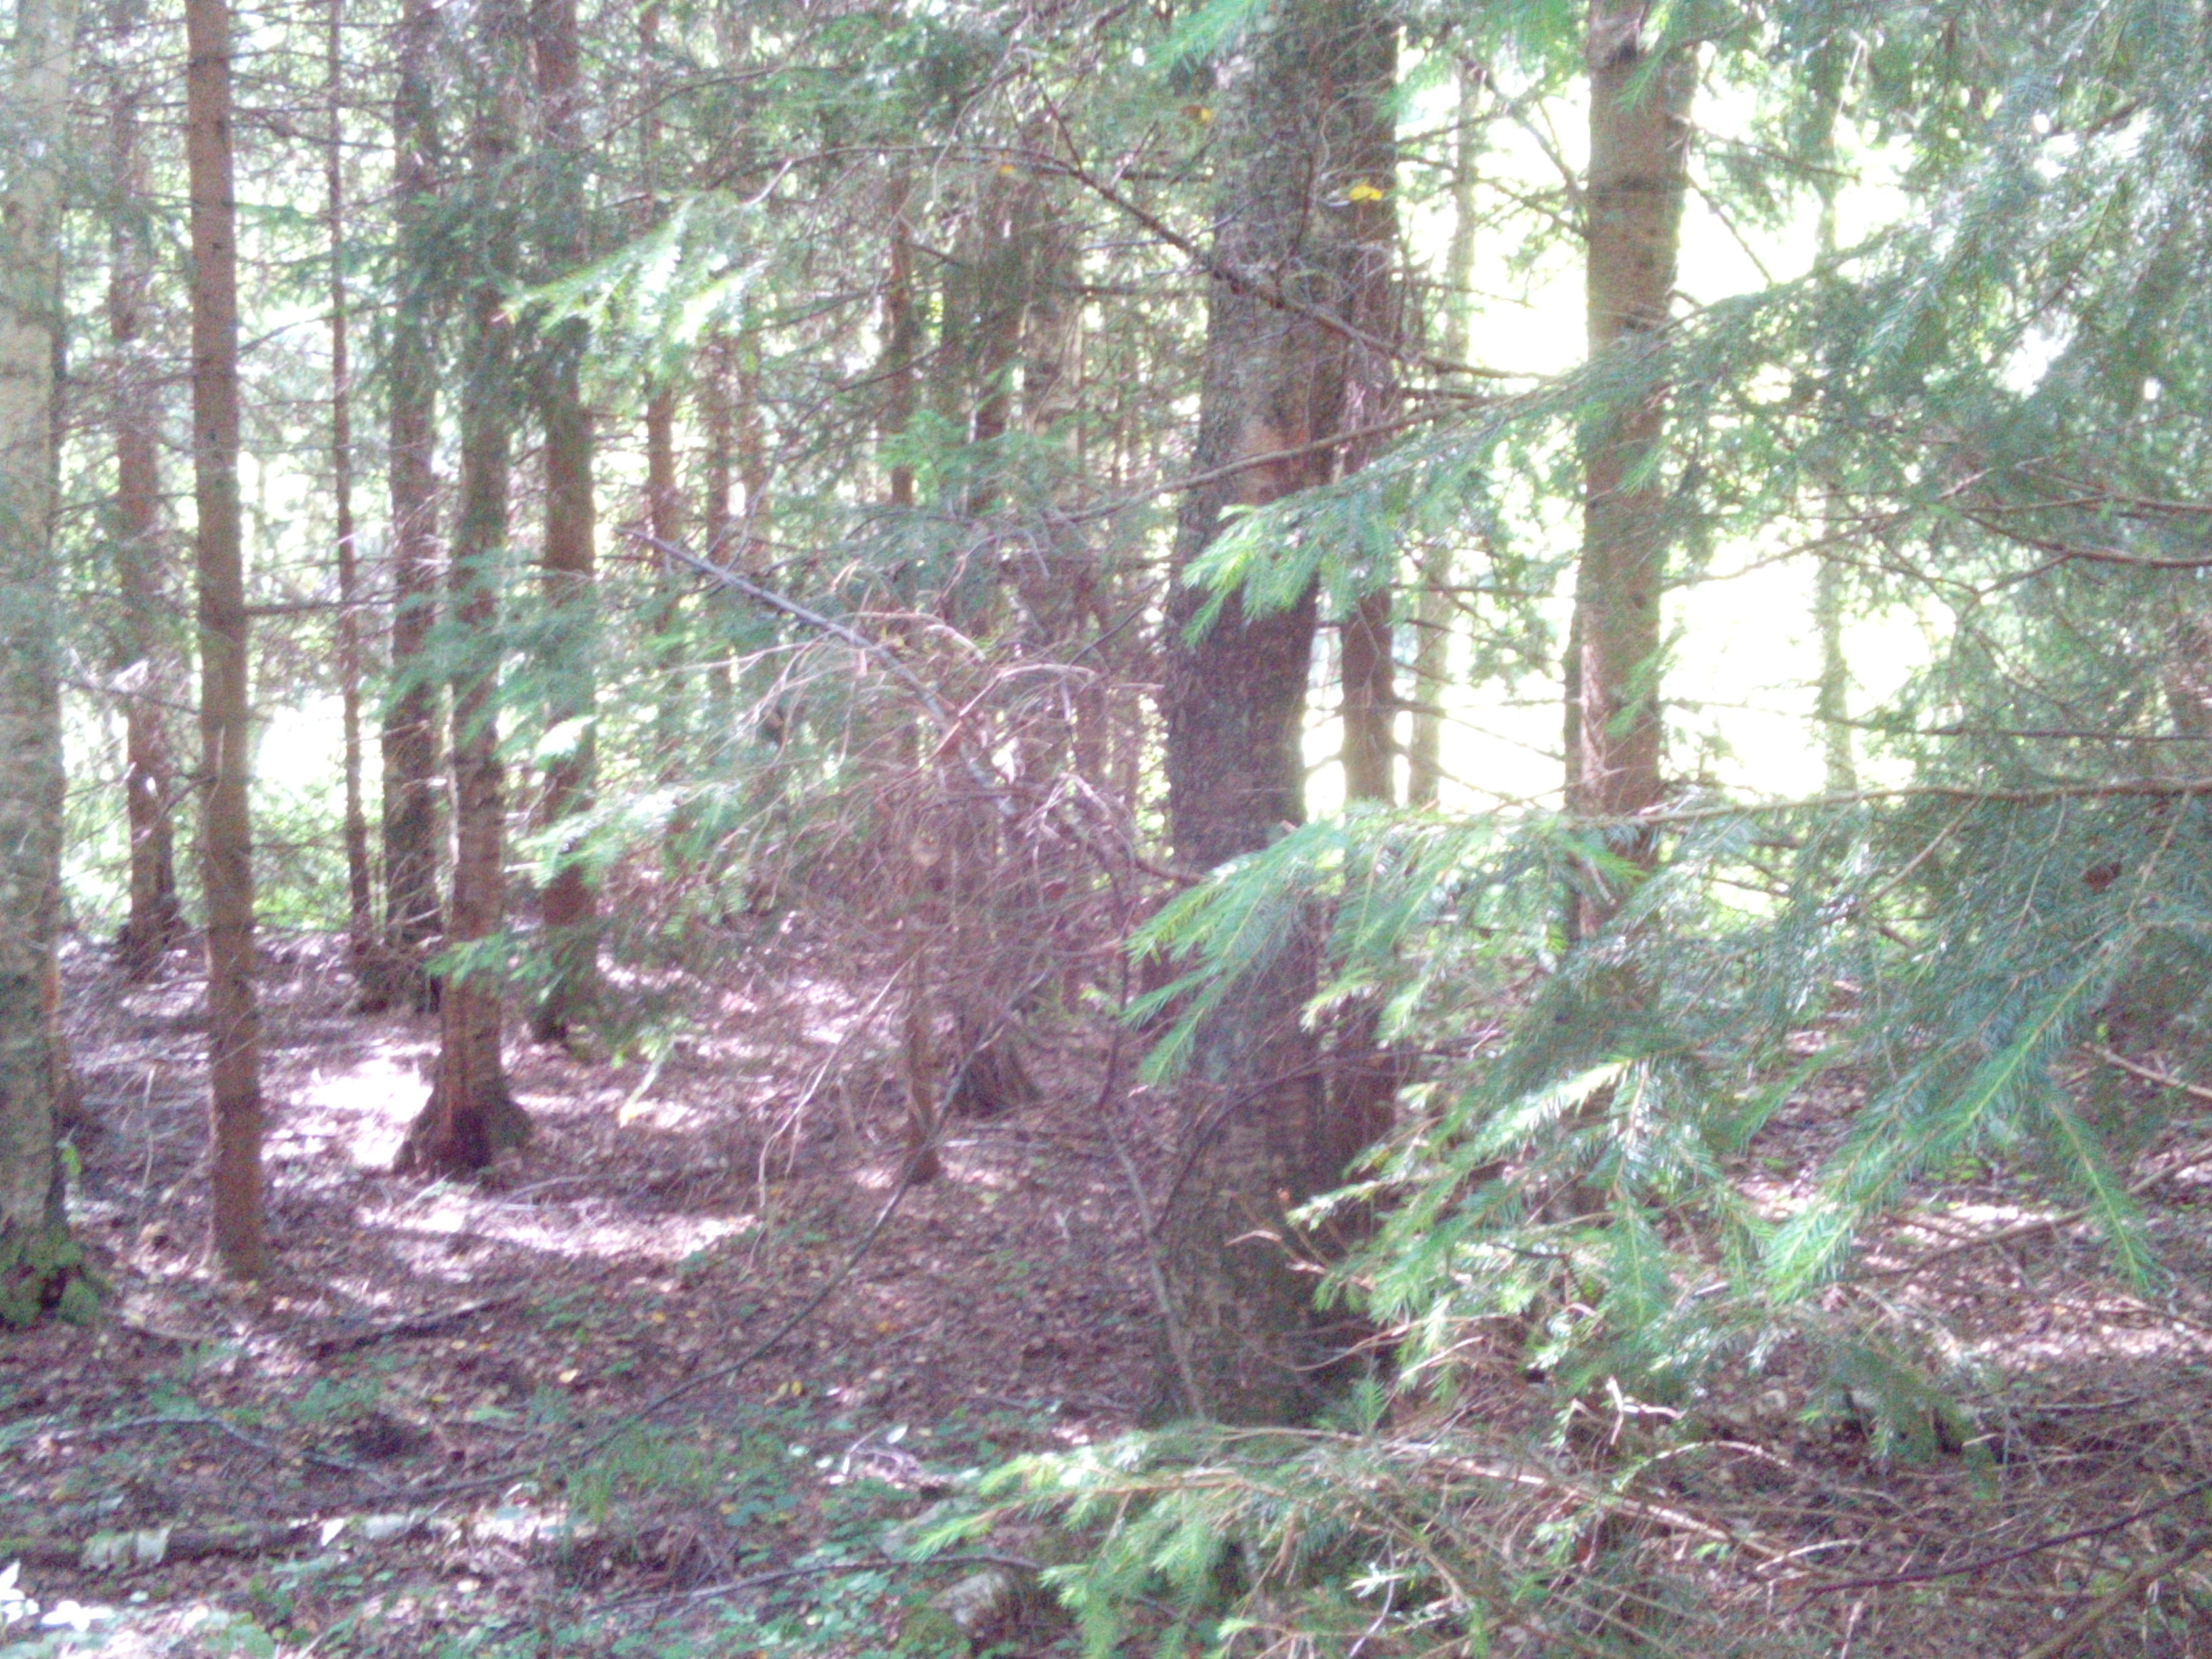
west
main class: Woodland
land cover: Spruce dominated mixed woodland
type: hemiboreal forest and nemoral coniferous forest and mixed broadleaved-coniferous forest
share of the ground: > 75 %
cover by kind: coniferous forest trees 40 %, broadleaved forest trees 40 %, herbaceous plants 10 %, unconsolidated bare surface 10 %
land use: Forestry
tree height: > 5 m
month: July
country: LV
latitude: 56.7734
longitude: 21.3462
